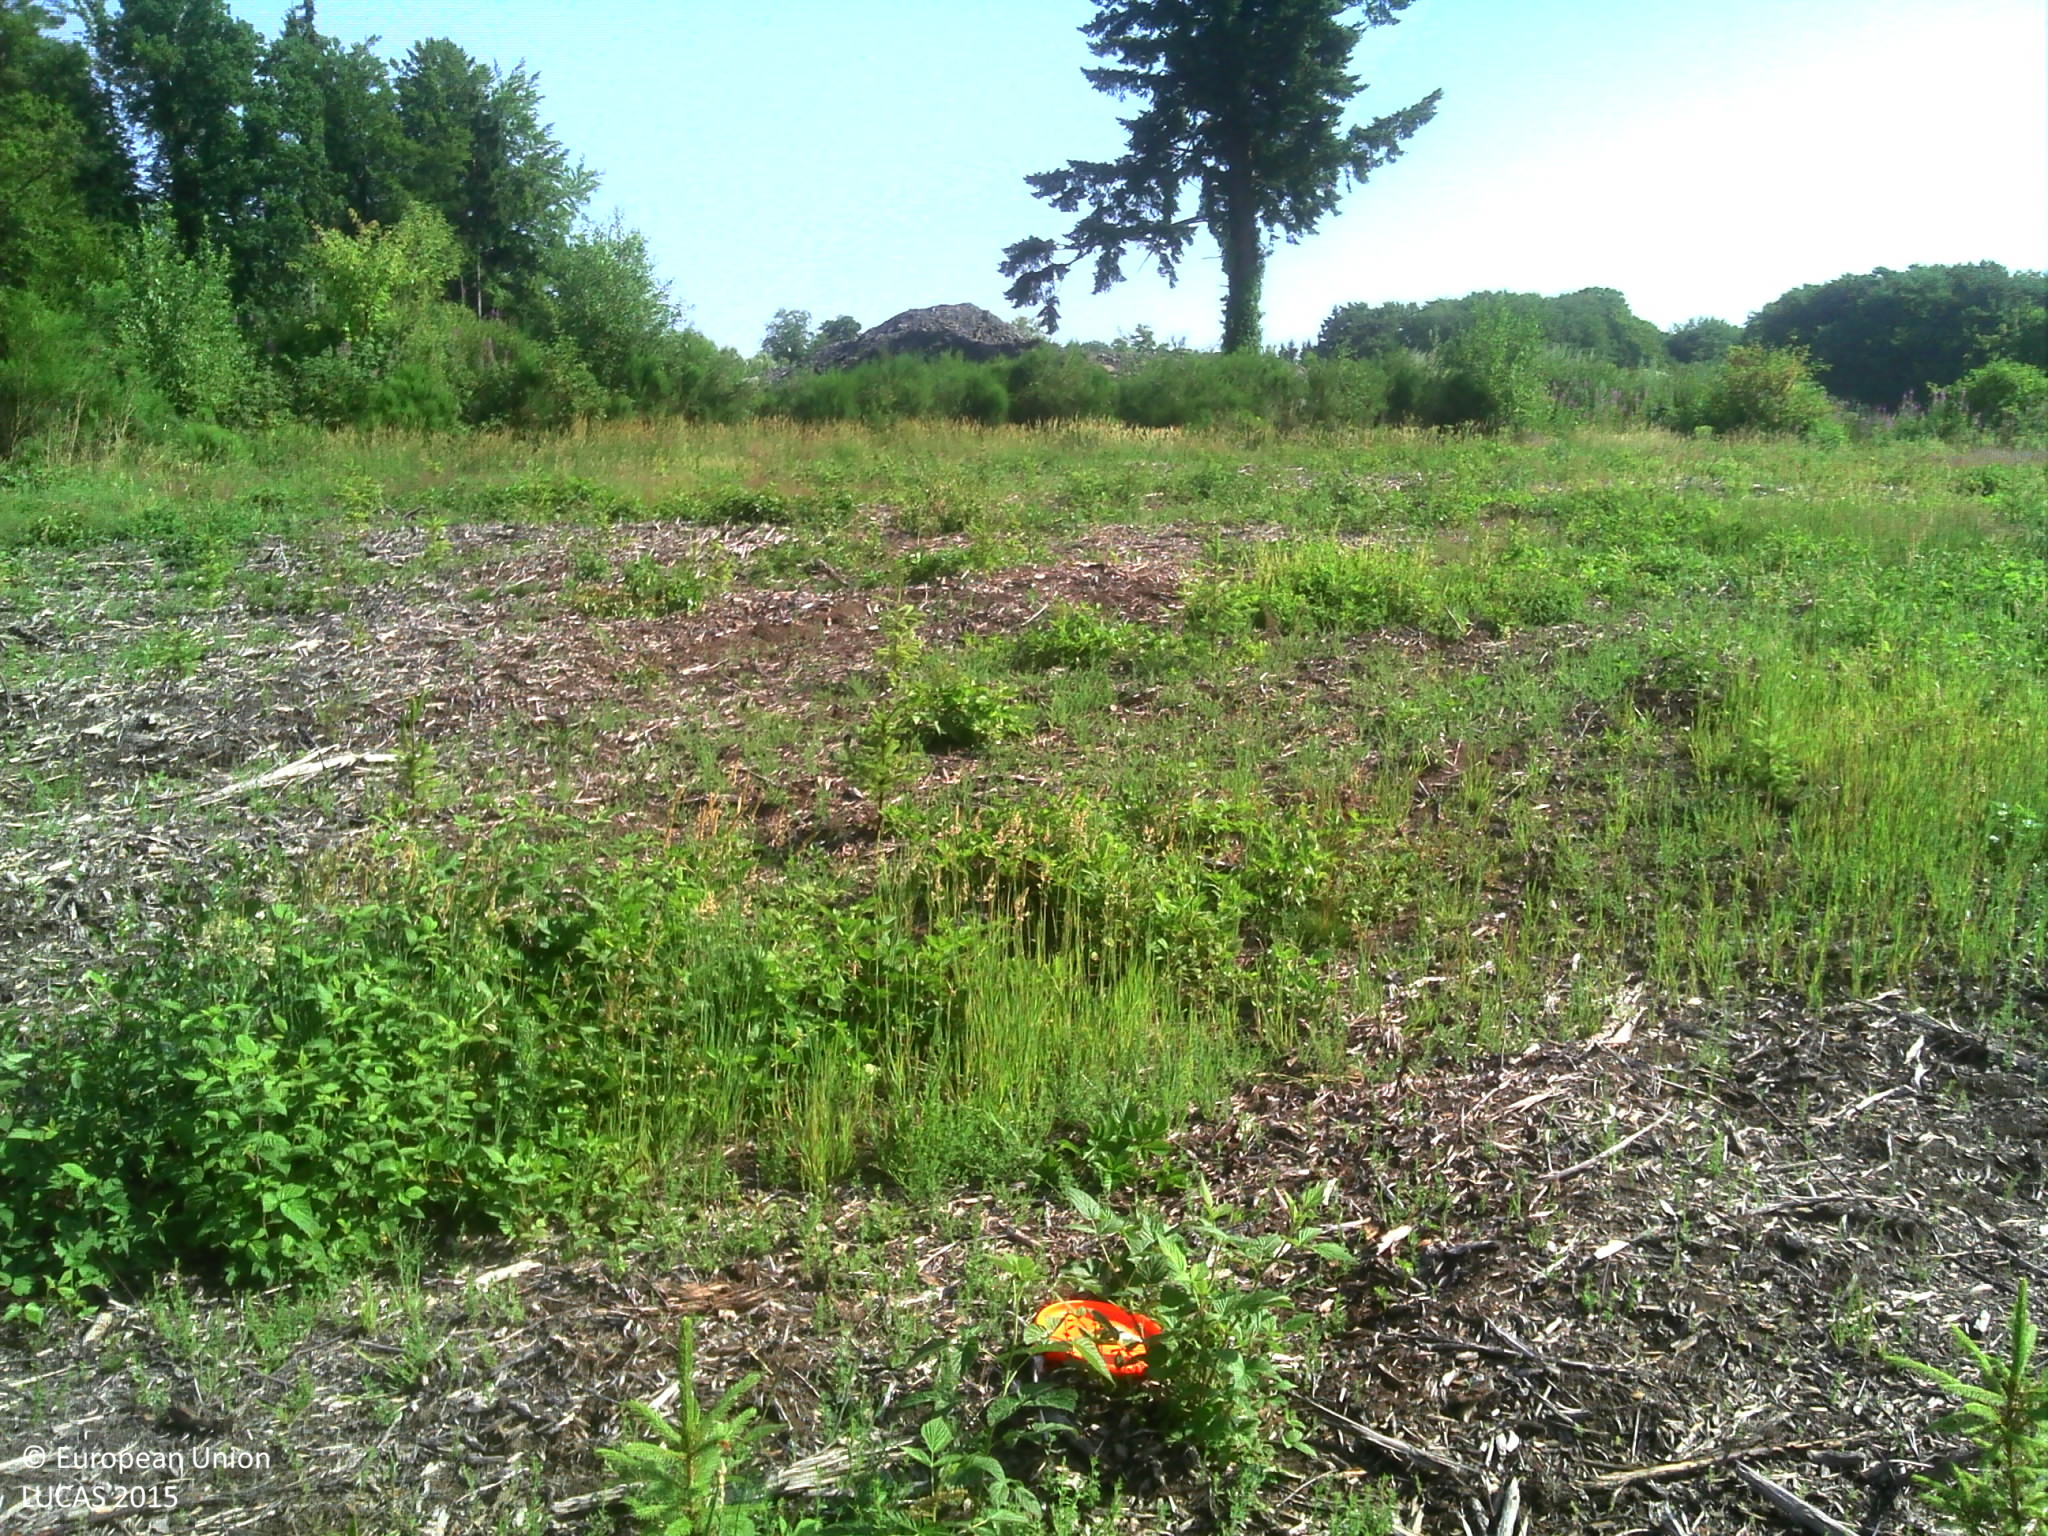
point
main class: Grassland
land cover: Spontaneously vegetated surfaces
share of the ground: 50 - 75 %
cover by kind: herbaceous plants 60 %, unconsolidated bare surface 35 %, shrubs 5 %
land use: Forestry
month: July
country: BE
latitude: 49.9567
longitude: 5.6358
